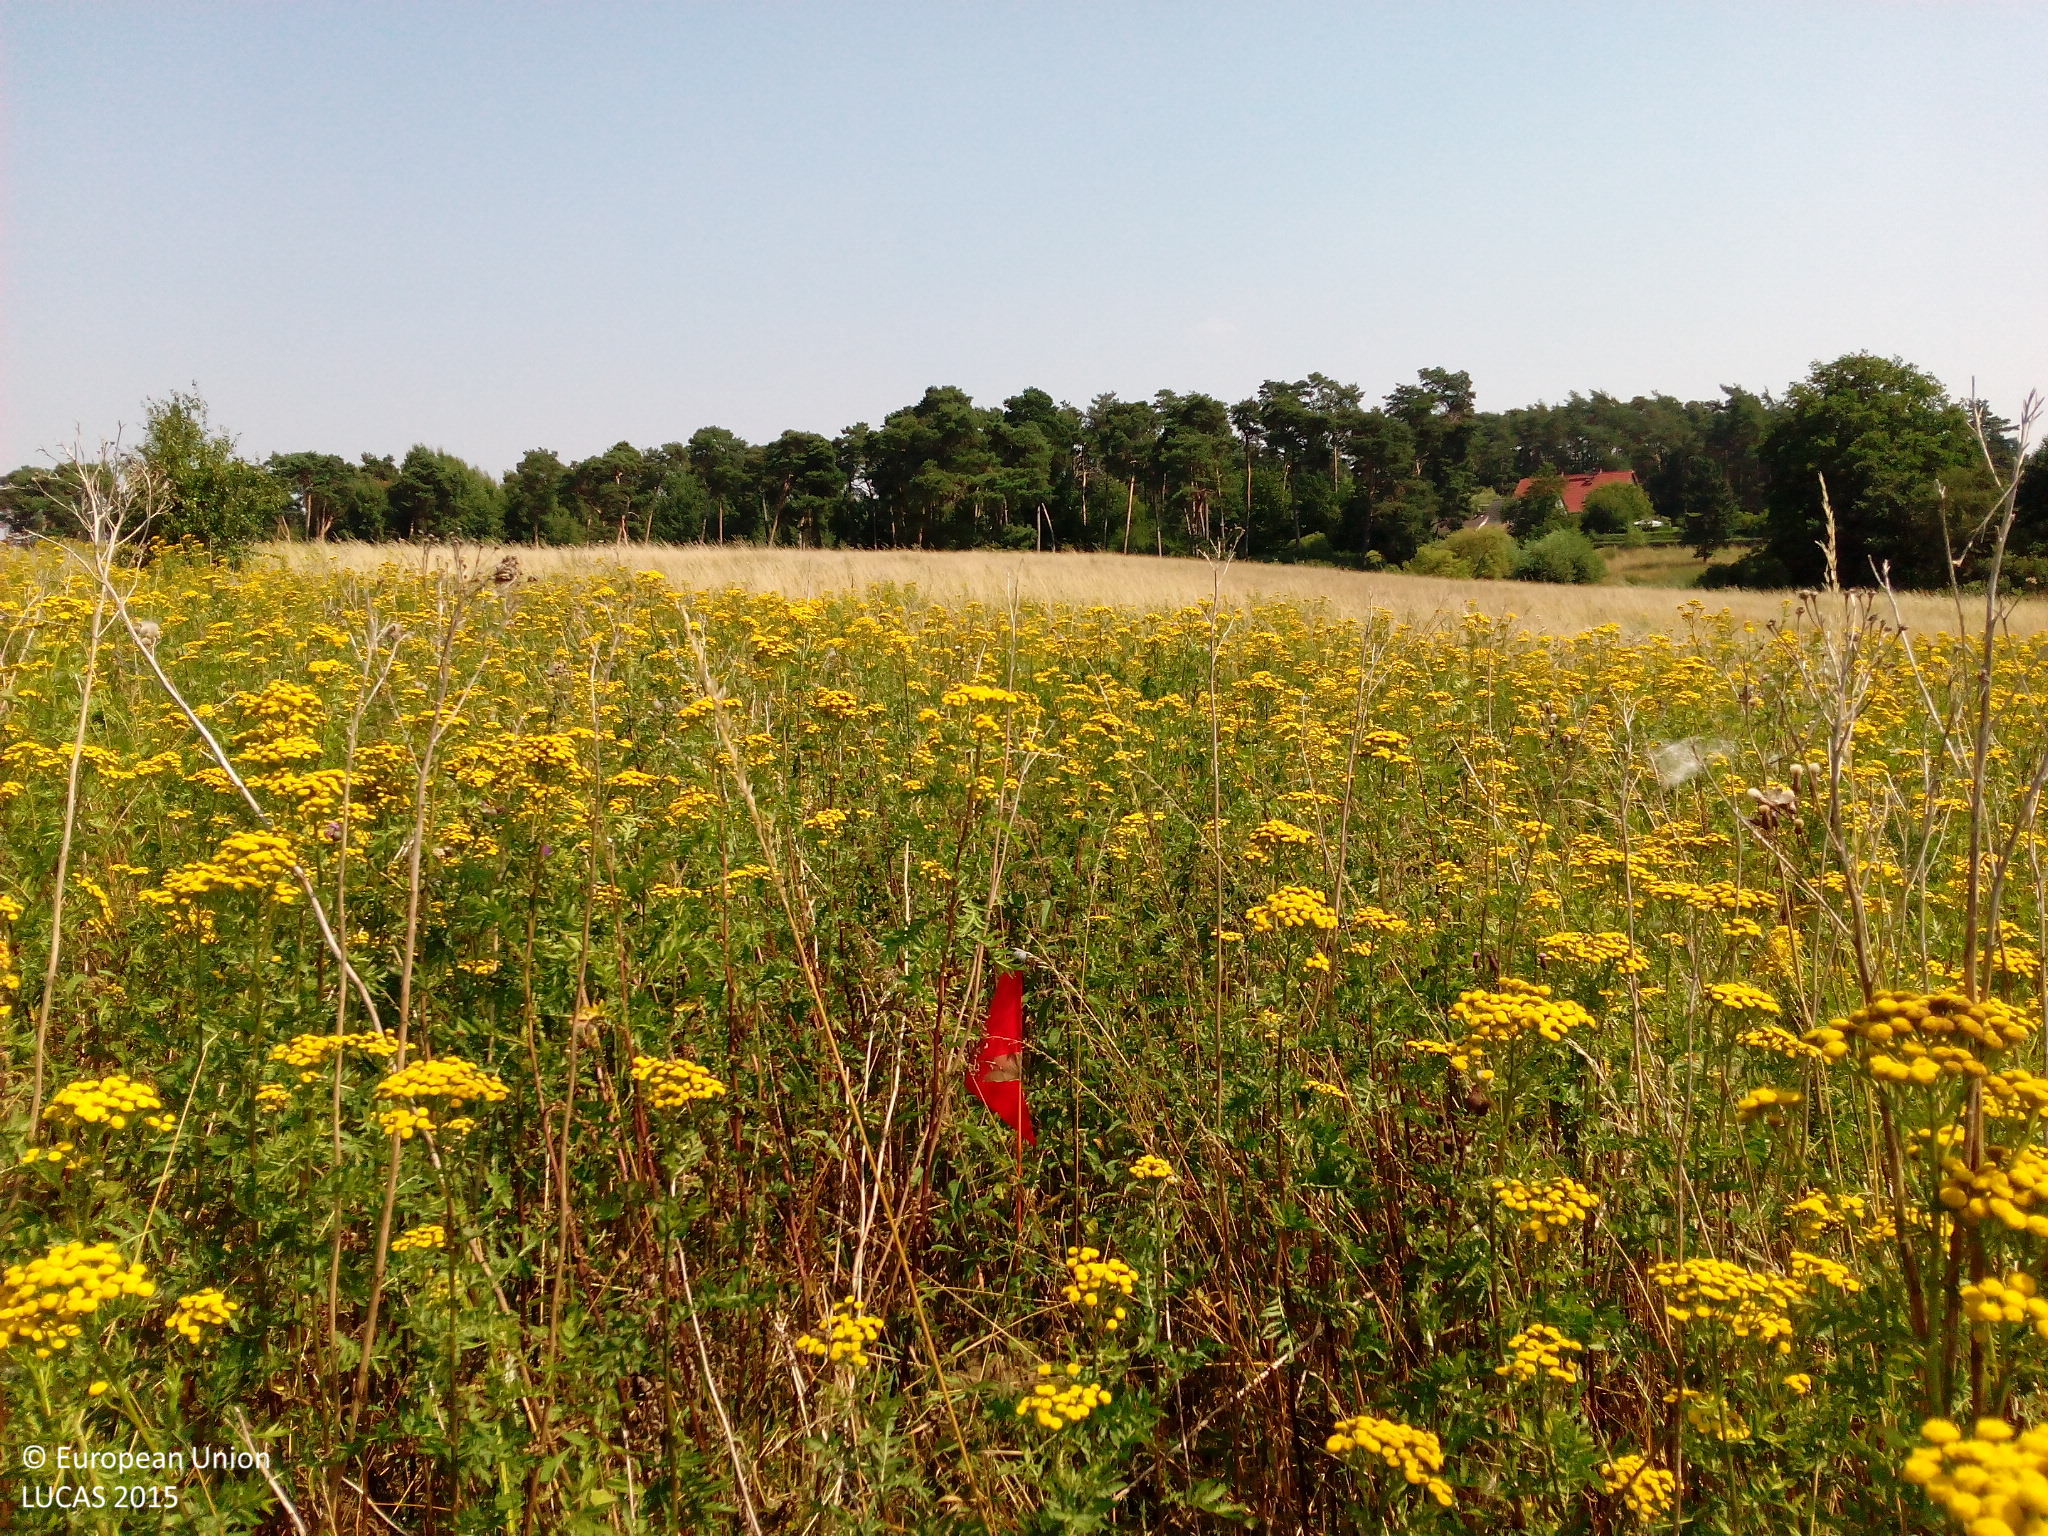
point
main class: Grassland
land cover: Spontaneously vegetated surfaces
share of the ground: > 75 %
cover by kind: herbaceous plants 100 %
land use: Fallow land
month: August
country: DE
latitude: 53.3308
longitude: 13.5887
